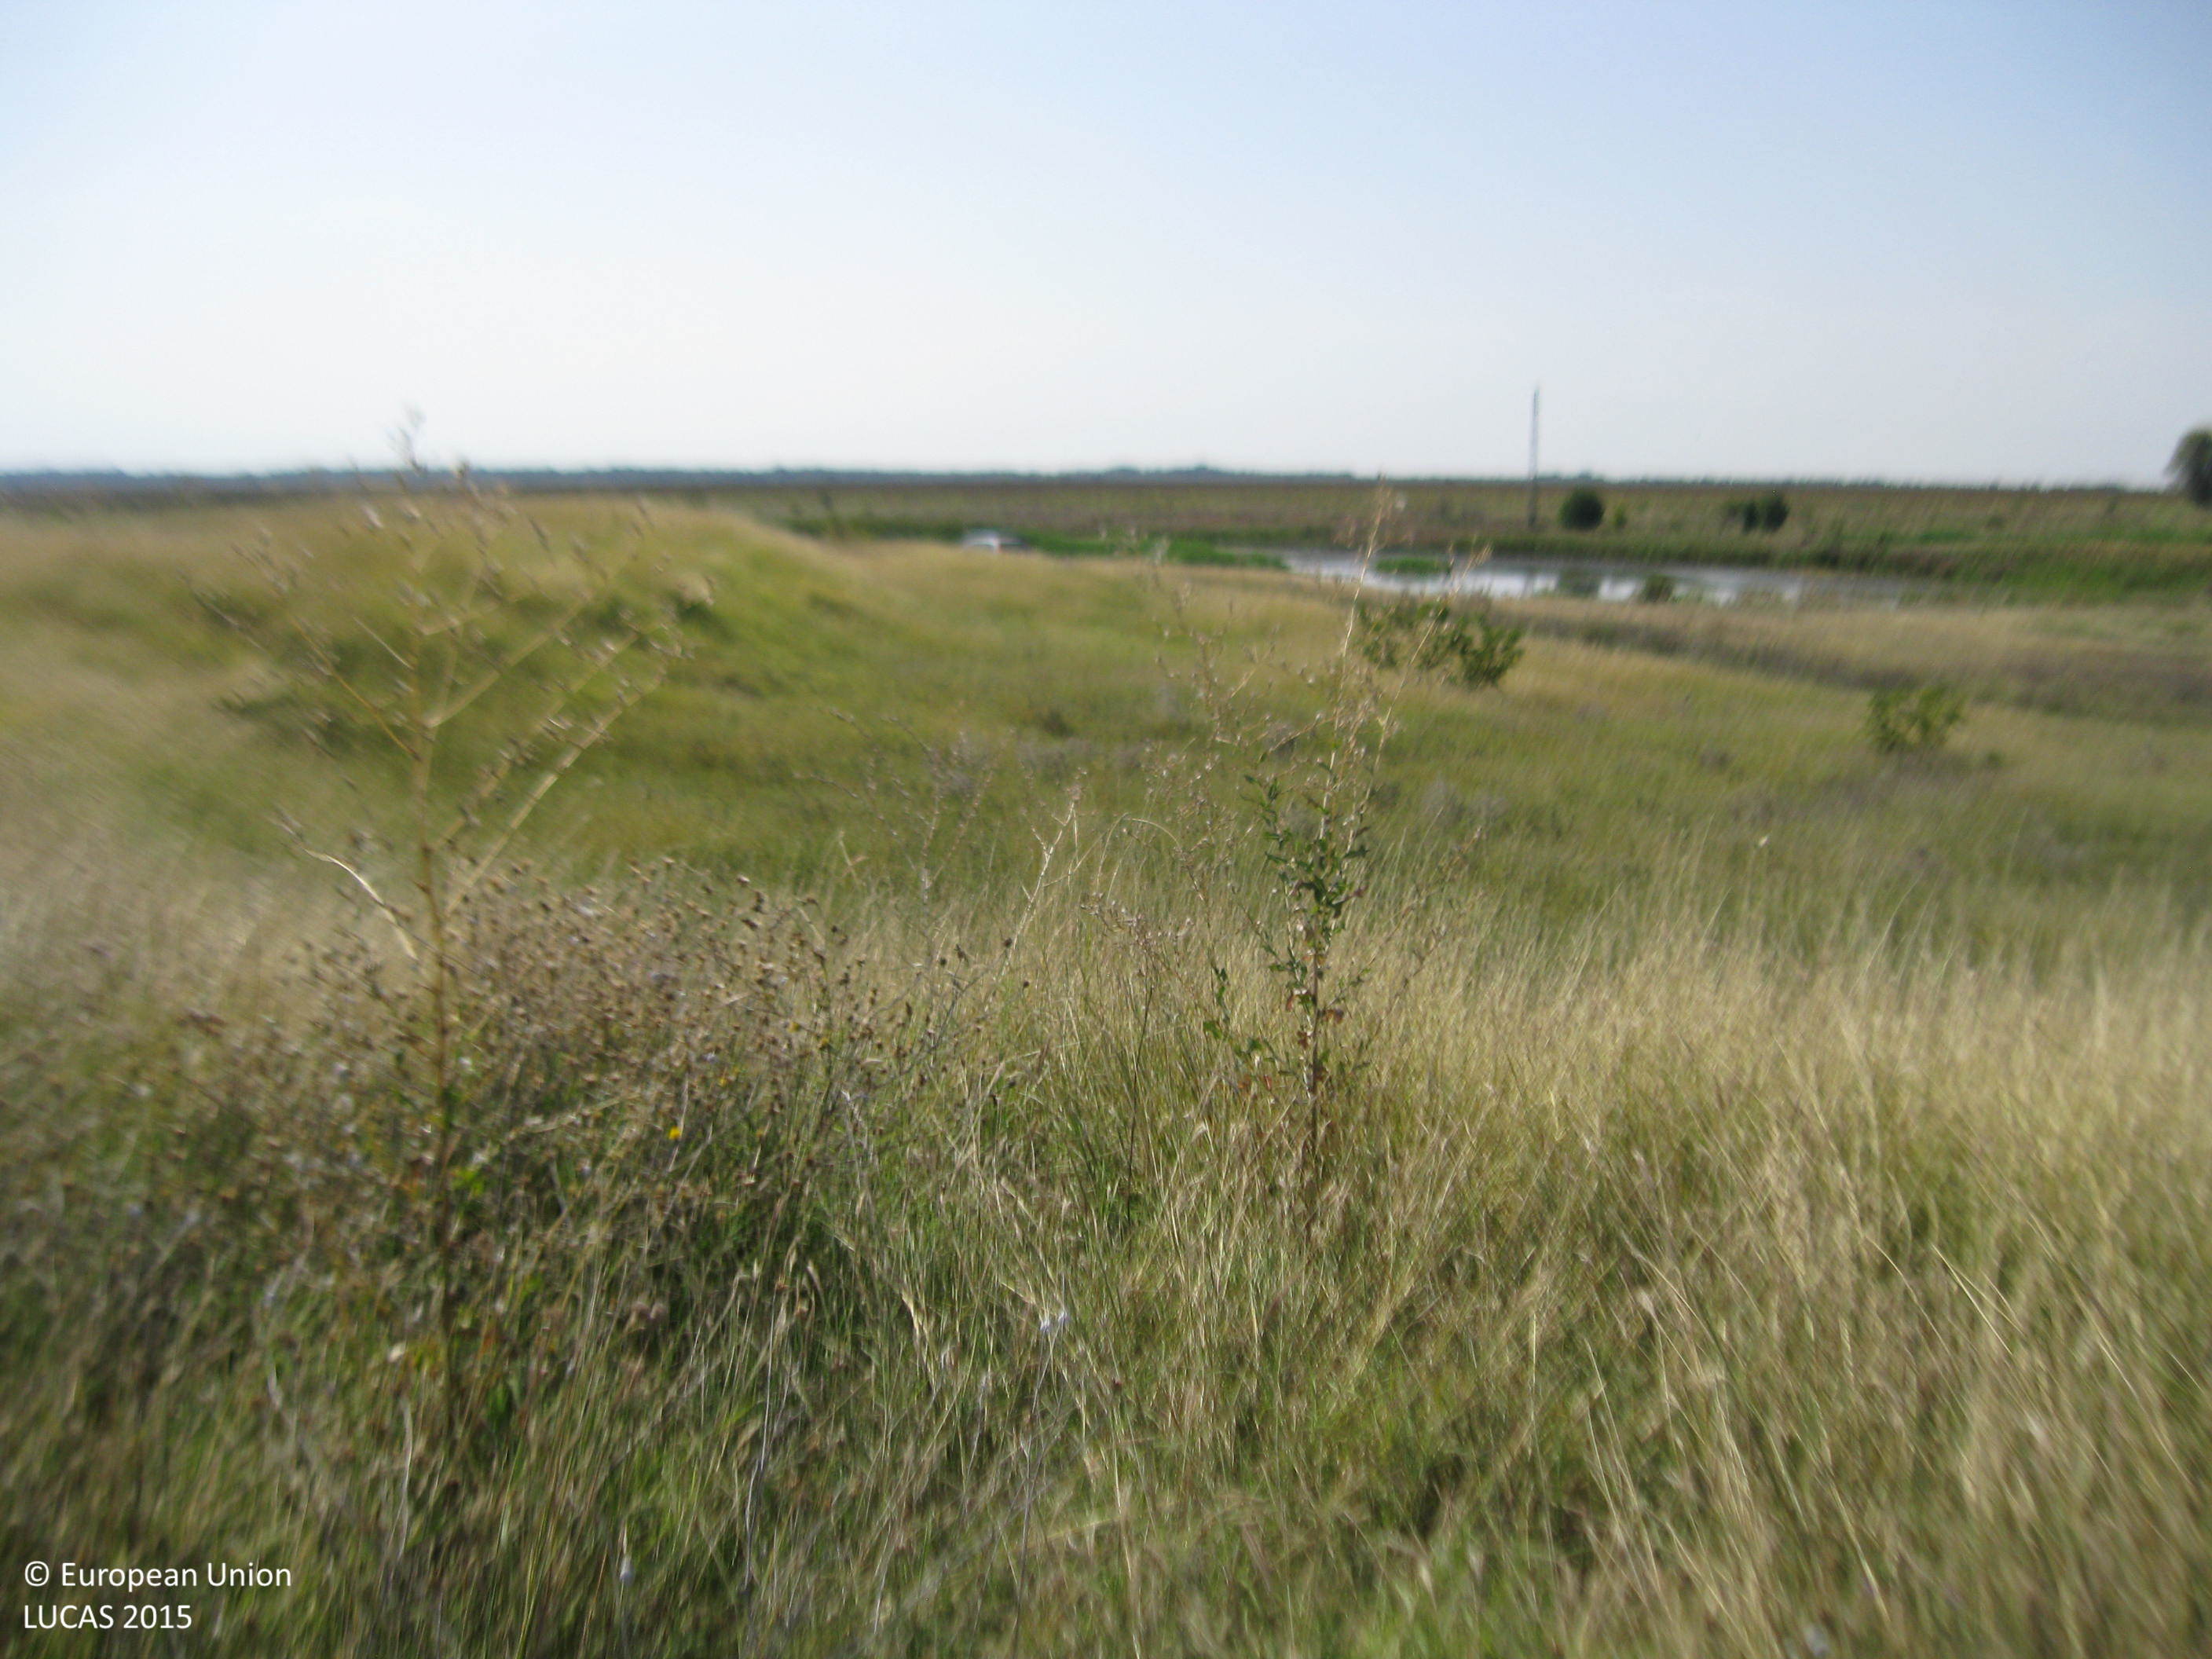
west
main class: Grassland
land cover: Grassland without tree/shrub cover
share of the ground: > 75 %
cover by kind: herbaceous plants 100 %
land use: Semi-natural and natural areas not in use
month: September
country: BG
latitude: 42.2552
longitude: 25.0525
